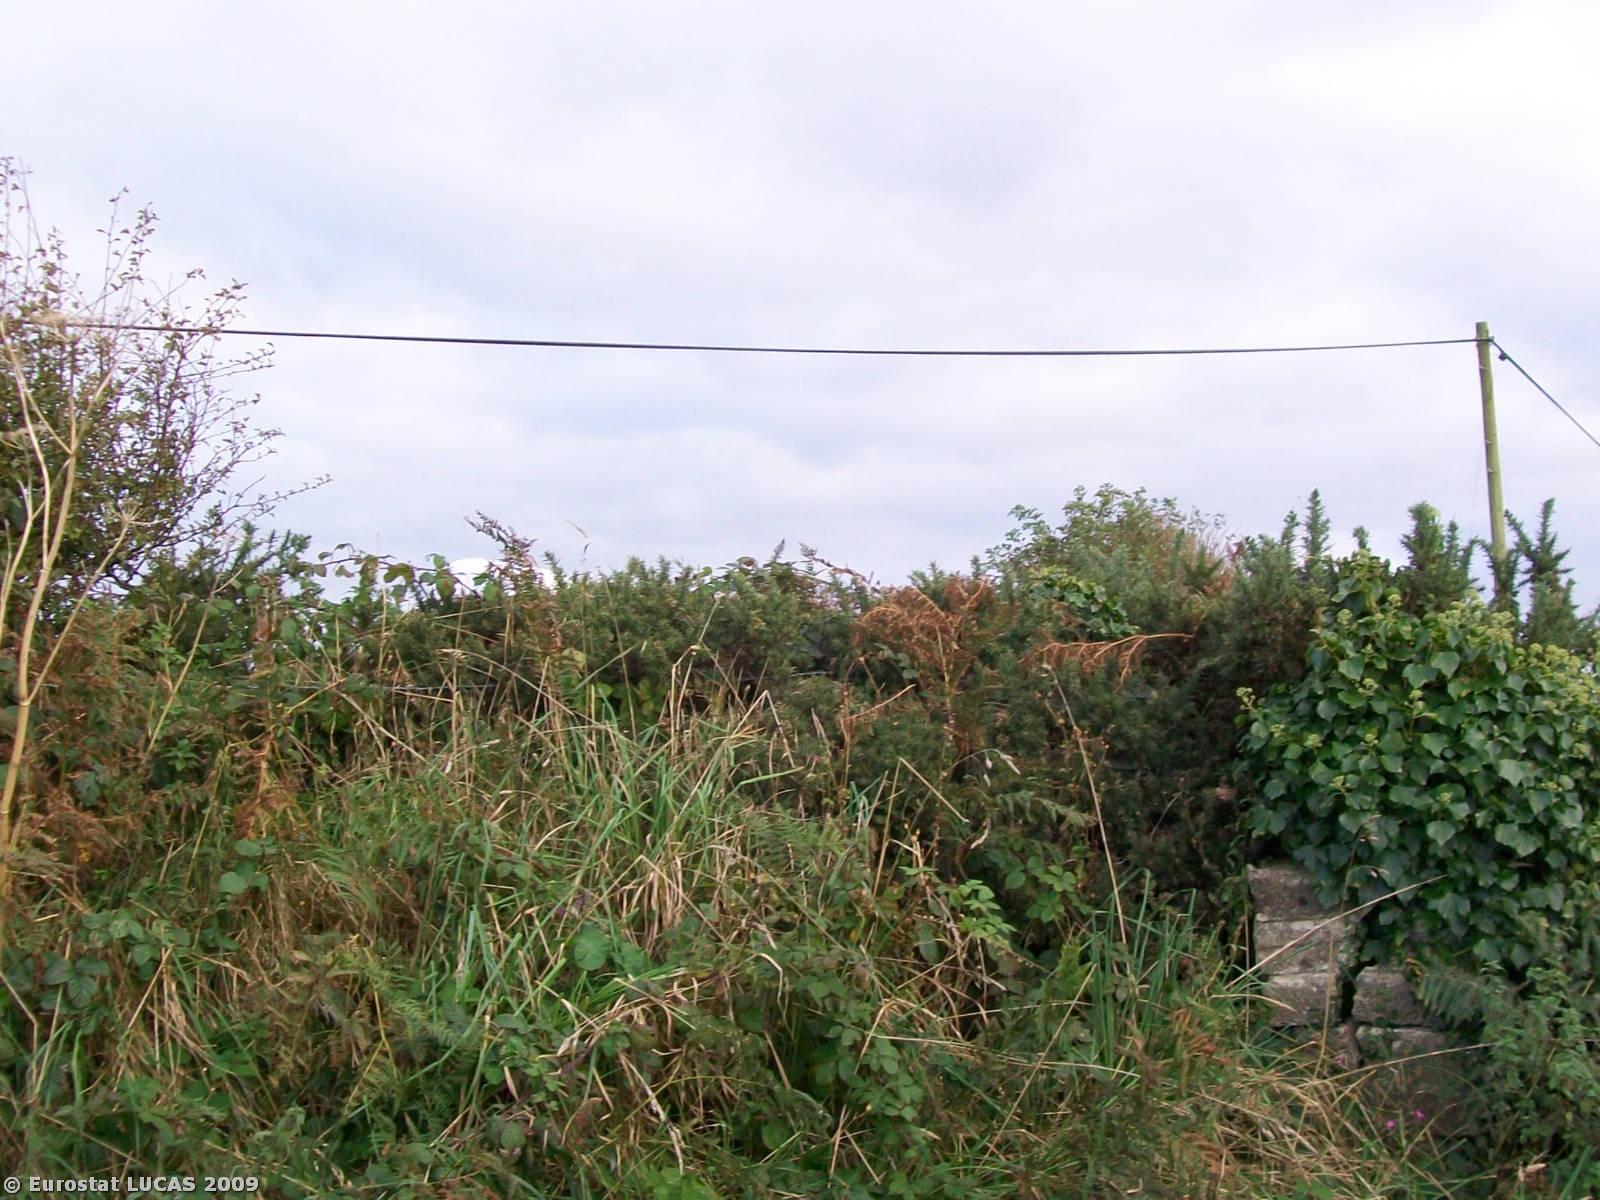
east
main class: Grassland
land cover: Grassland without tree/shrub cover
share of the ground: > 75 %
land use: Agriculture (excluding fallow land and kitchen gardens)
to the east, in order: Grassland without tree/shrub cover; Managed hedges; Grassland without tree/shrub cover; Managed hedges; Tracks; Managed hedges; Grassland without tree/shrub cover
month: September
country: GB
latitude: 51.9613
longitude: -5.0351
